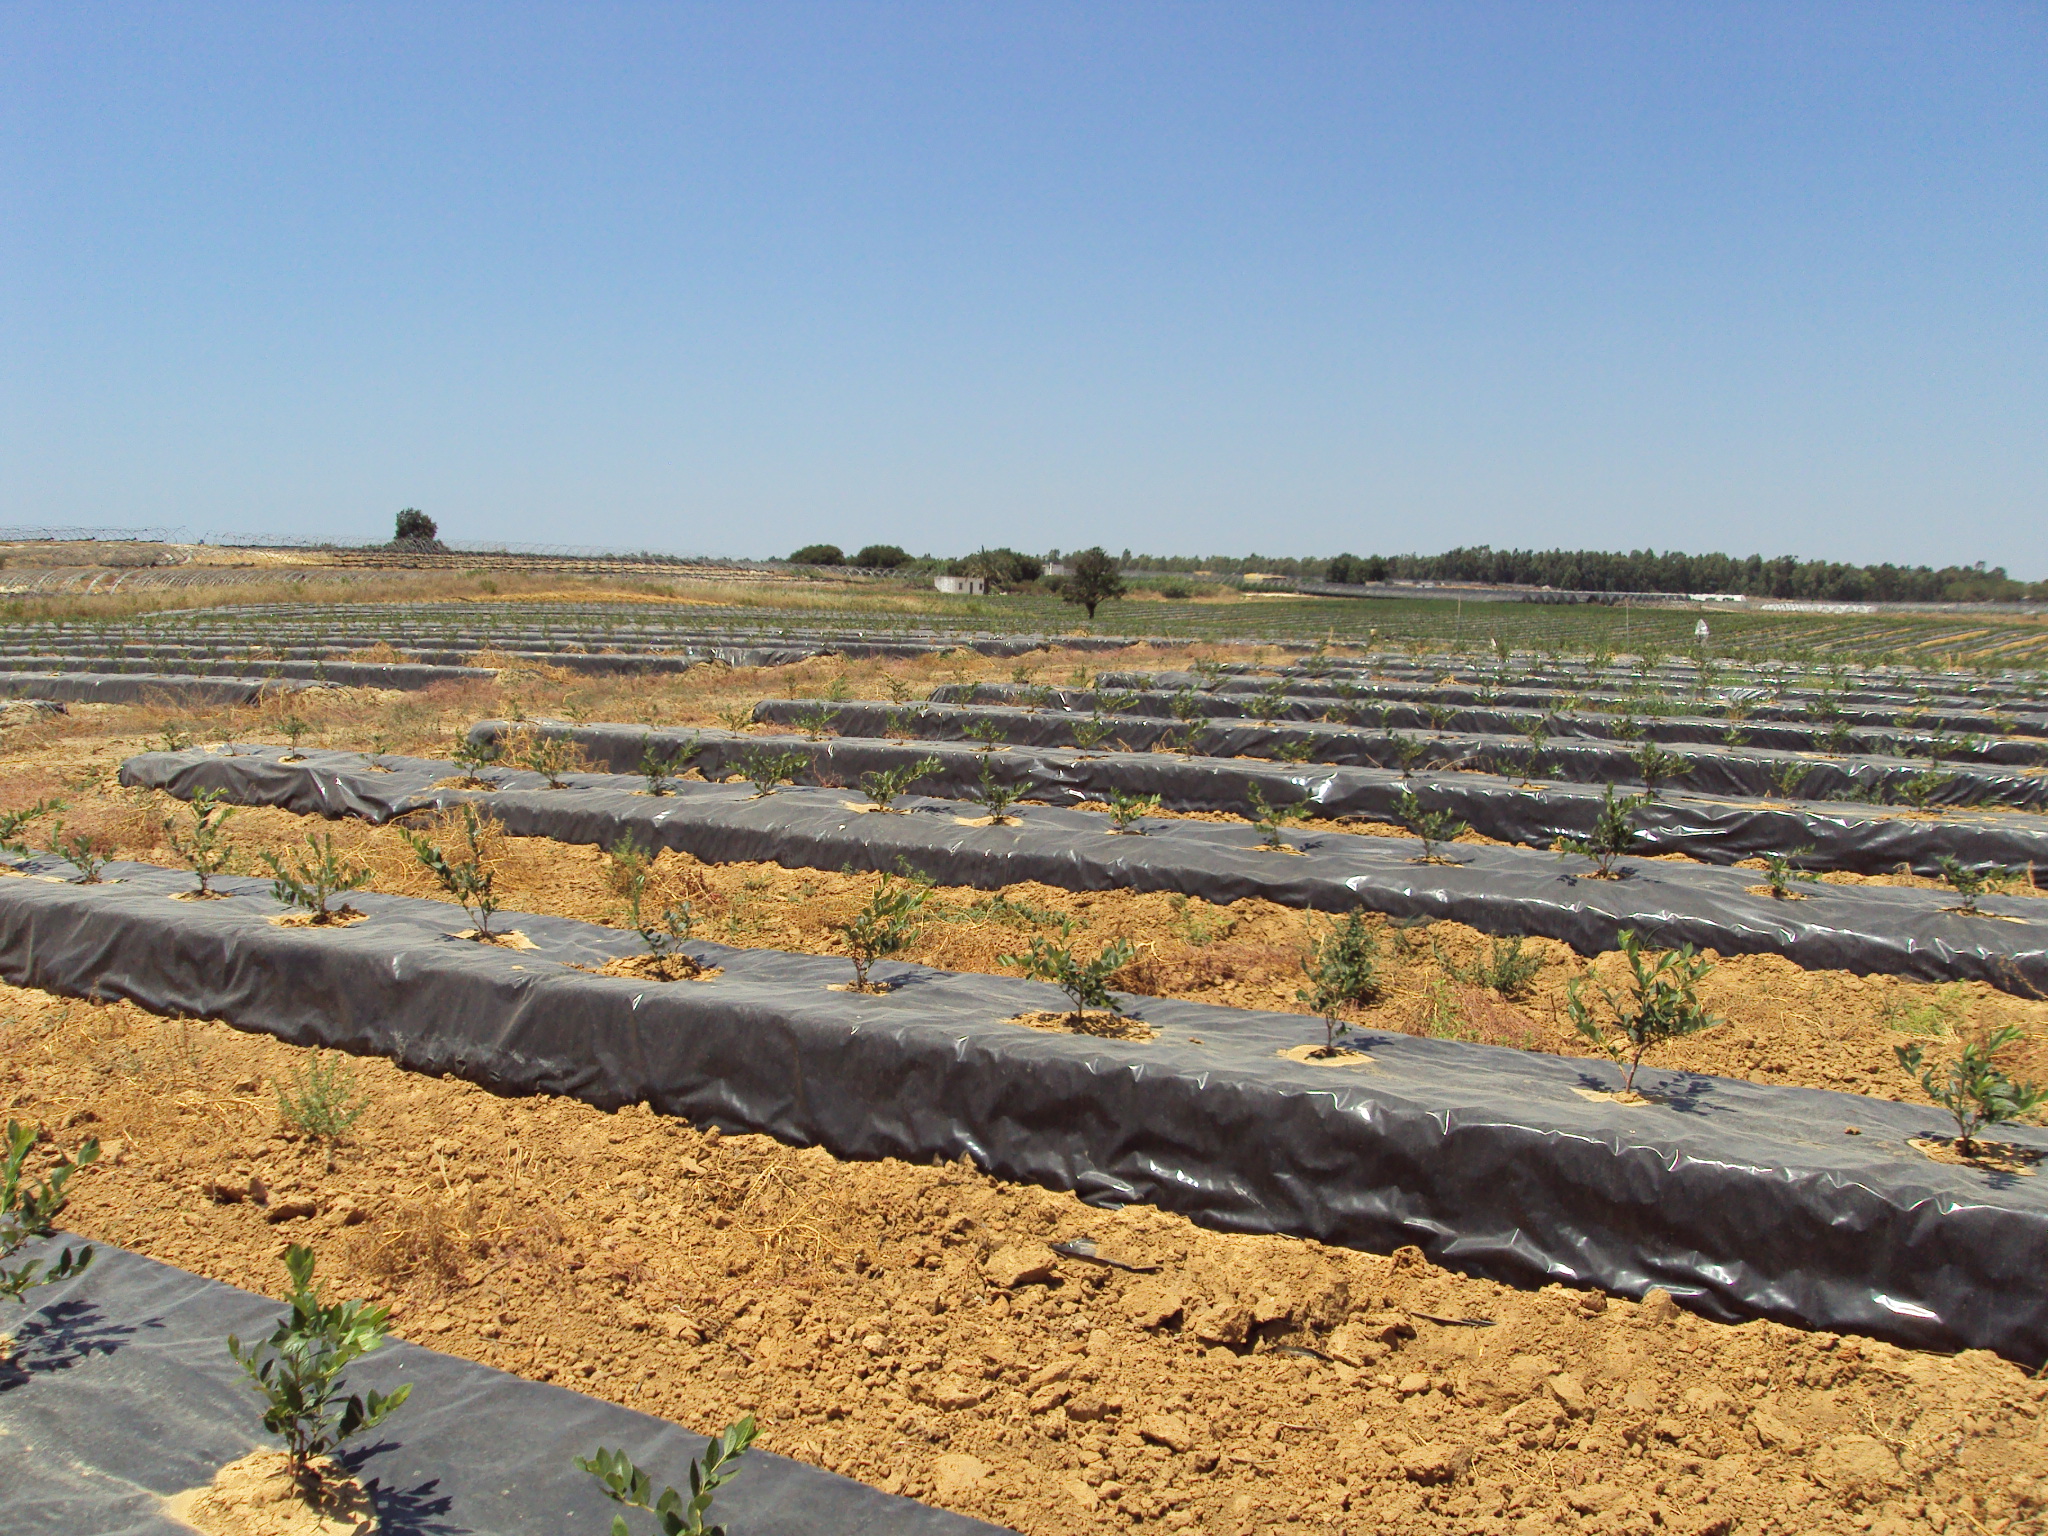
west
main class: Cropland
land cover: Other fruit trees and berries
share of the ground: 10 - 25 %
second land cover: Other bare soil
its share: > 75 %
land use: Agriculture (excluding fallow land and kitchen gardens)
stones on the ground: < 10 %
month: July
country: ES
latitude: 37.2569
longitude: -6.5946
